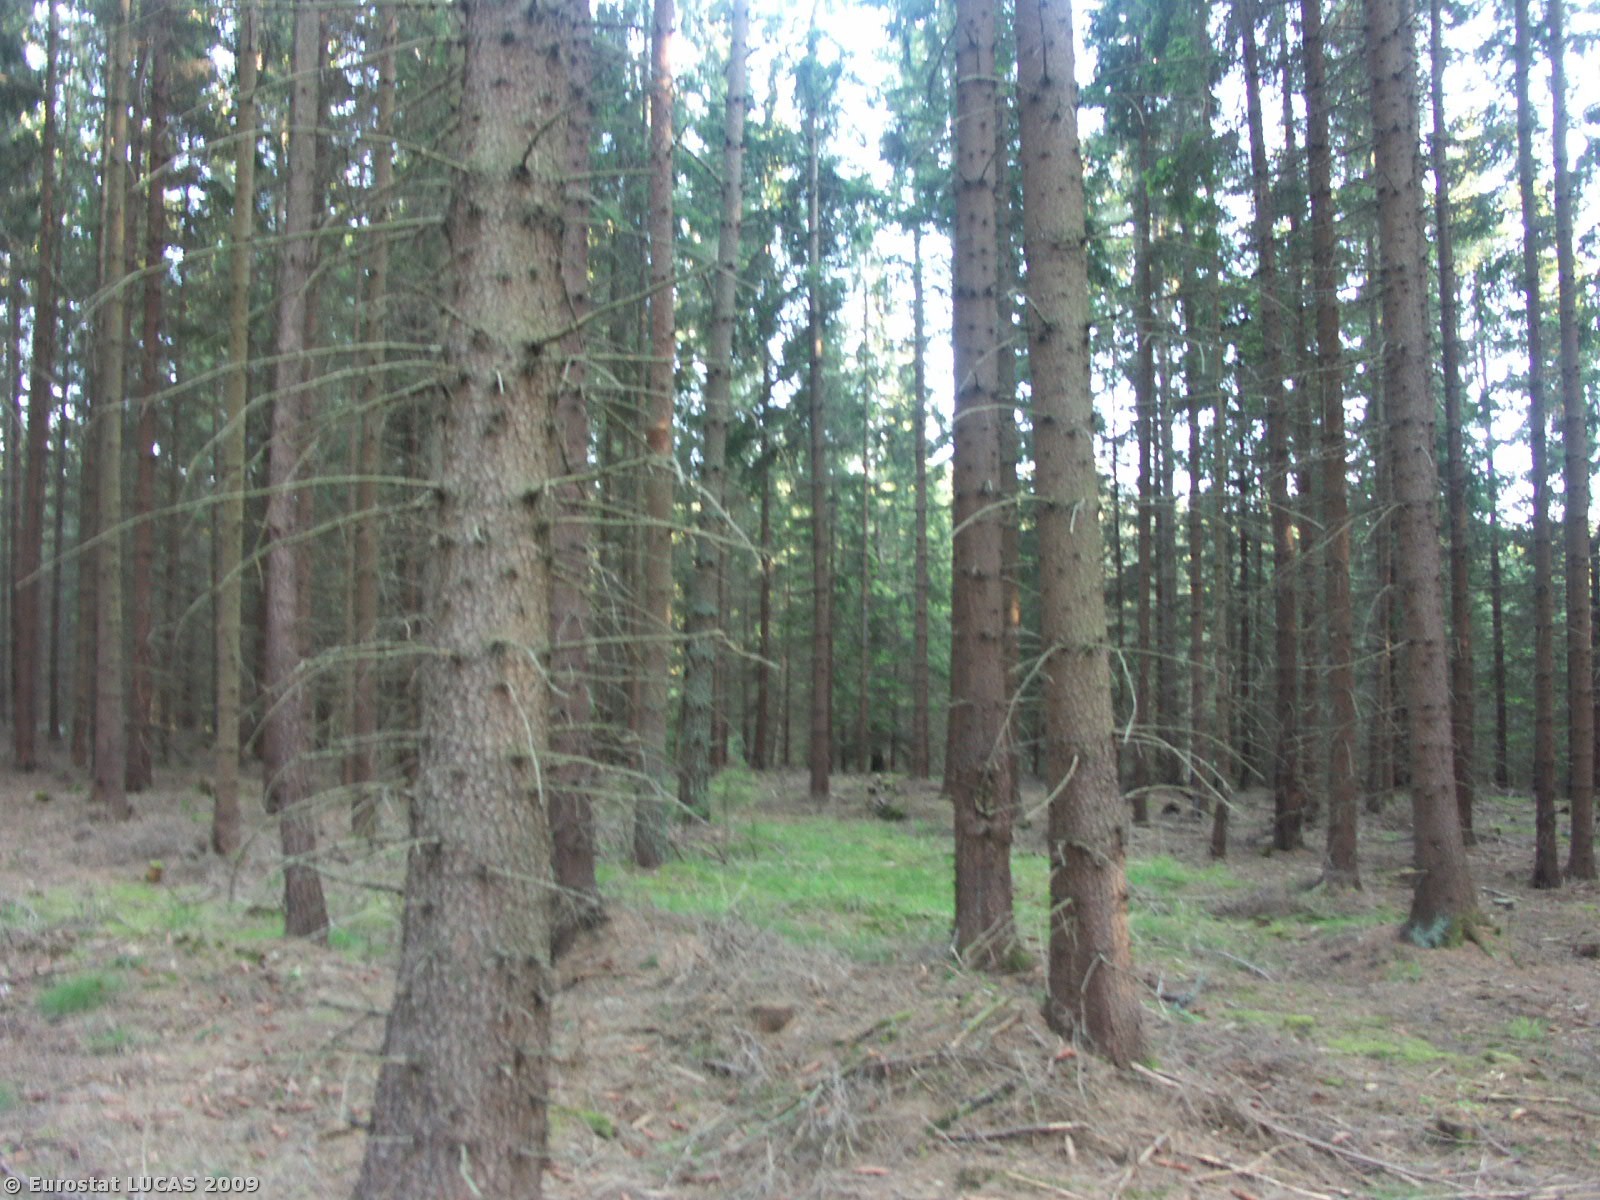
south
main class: Woodland
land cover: Coniferous woodland
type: hemiboreal forest and nemoral coniferous forest and mixed broadleaved-coniferous forest
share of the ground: > 75 %
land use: Forestry
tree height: > 5 m
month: May
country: CZ
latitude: 49.0492
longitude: 15.3528
